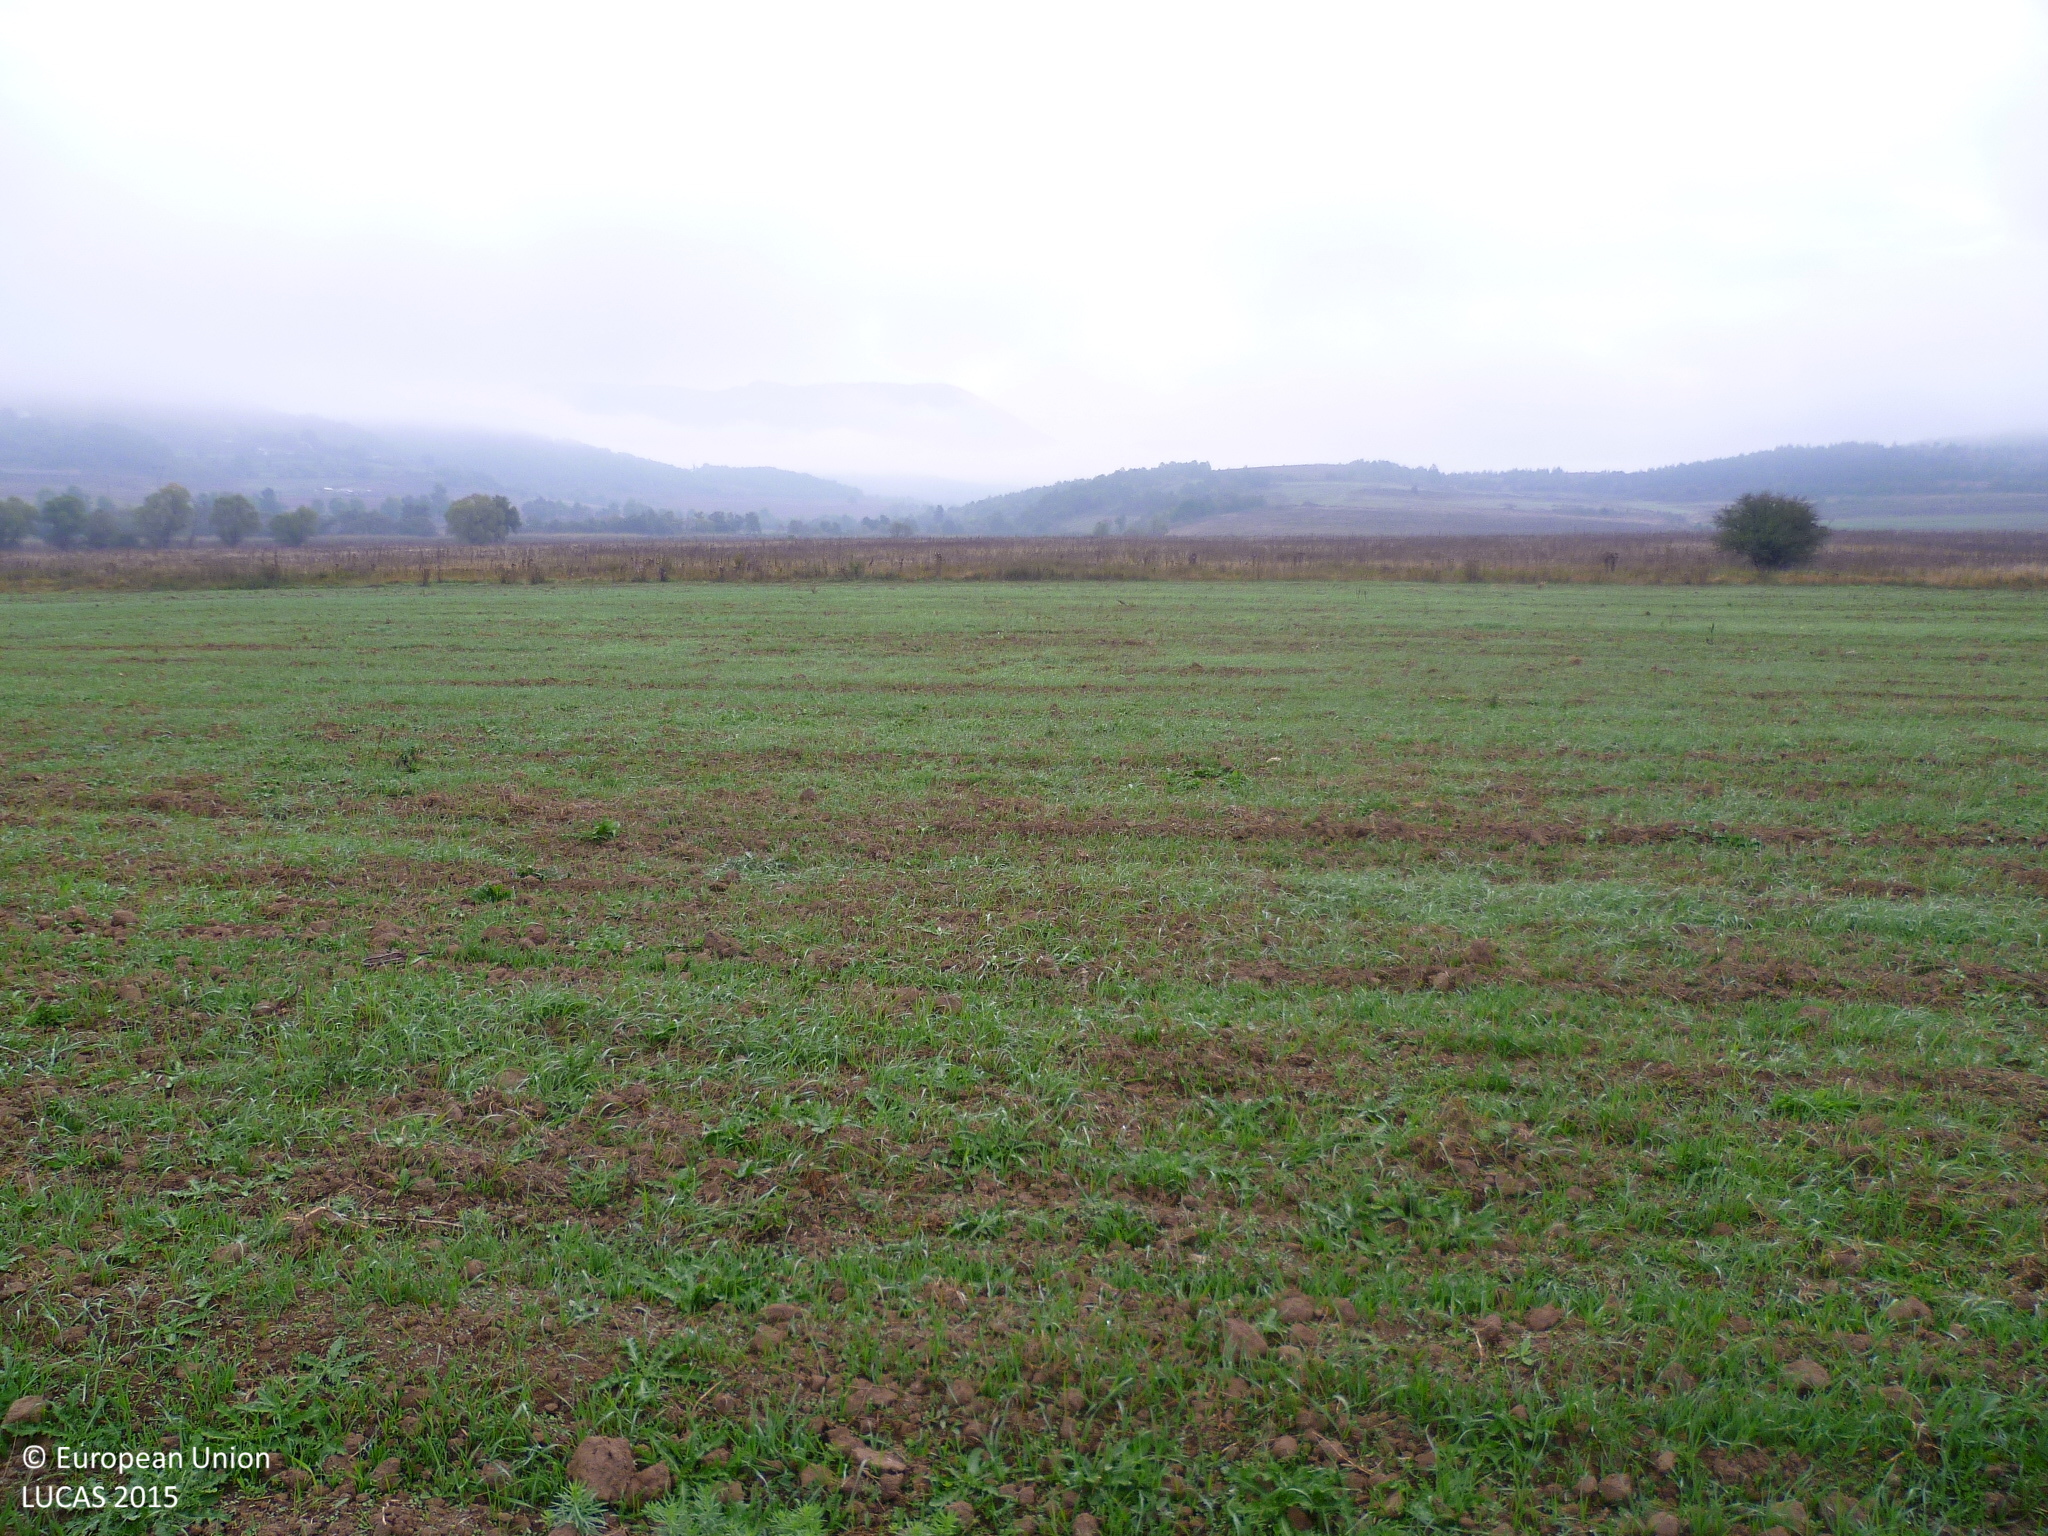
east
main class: Cropland
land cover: Common wheat
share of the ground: 25 - 50 %
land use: Agriculture (excluding fallow land and kitchen gardens)
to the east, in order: Common wheat; Ditches and canals; Spontaneously vegetated surfaces; Ditches and canals; Spontaneously vegetated surfaces
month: October
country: BG
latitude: 42.8087
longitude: 22.6339
